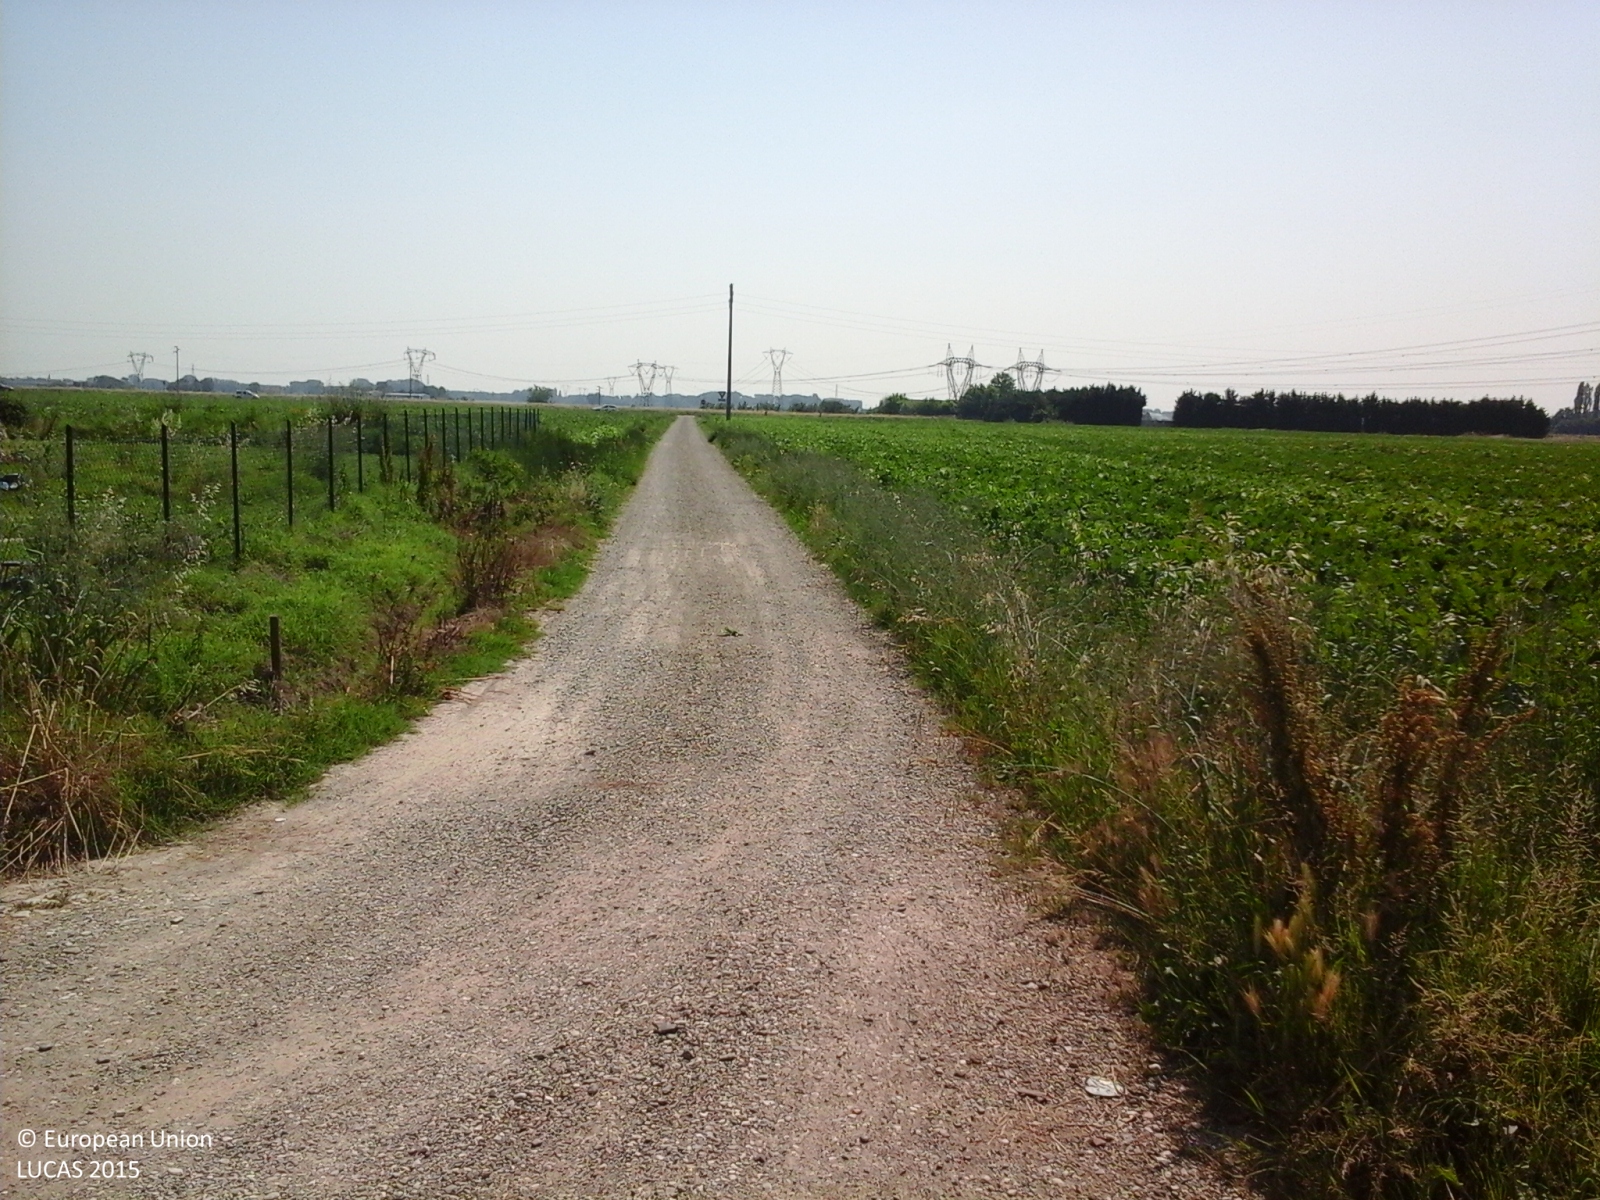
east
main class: Grassland
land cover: Grassland without tree/shrub cover
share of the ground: > 75 %
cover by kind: herbaceous plants 100 %
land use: Residential
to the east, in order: Grassland without tree/shrub cover; Fences; Sugar beet; Ditches and canals; Sugar beet; Electric lines; Sugar beet; Ditches and canals; Paved roads, cycling and walking lanes
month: June
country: IT
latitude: 44.5601
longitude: 11.1935
